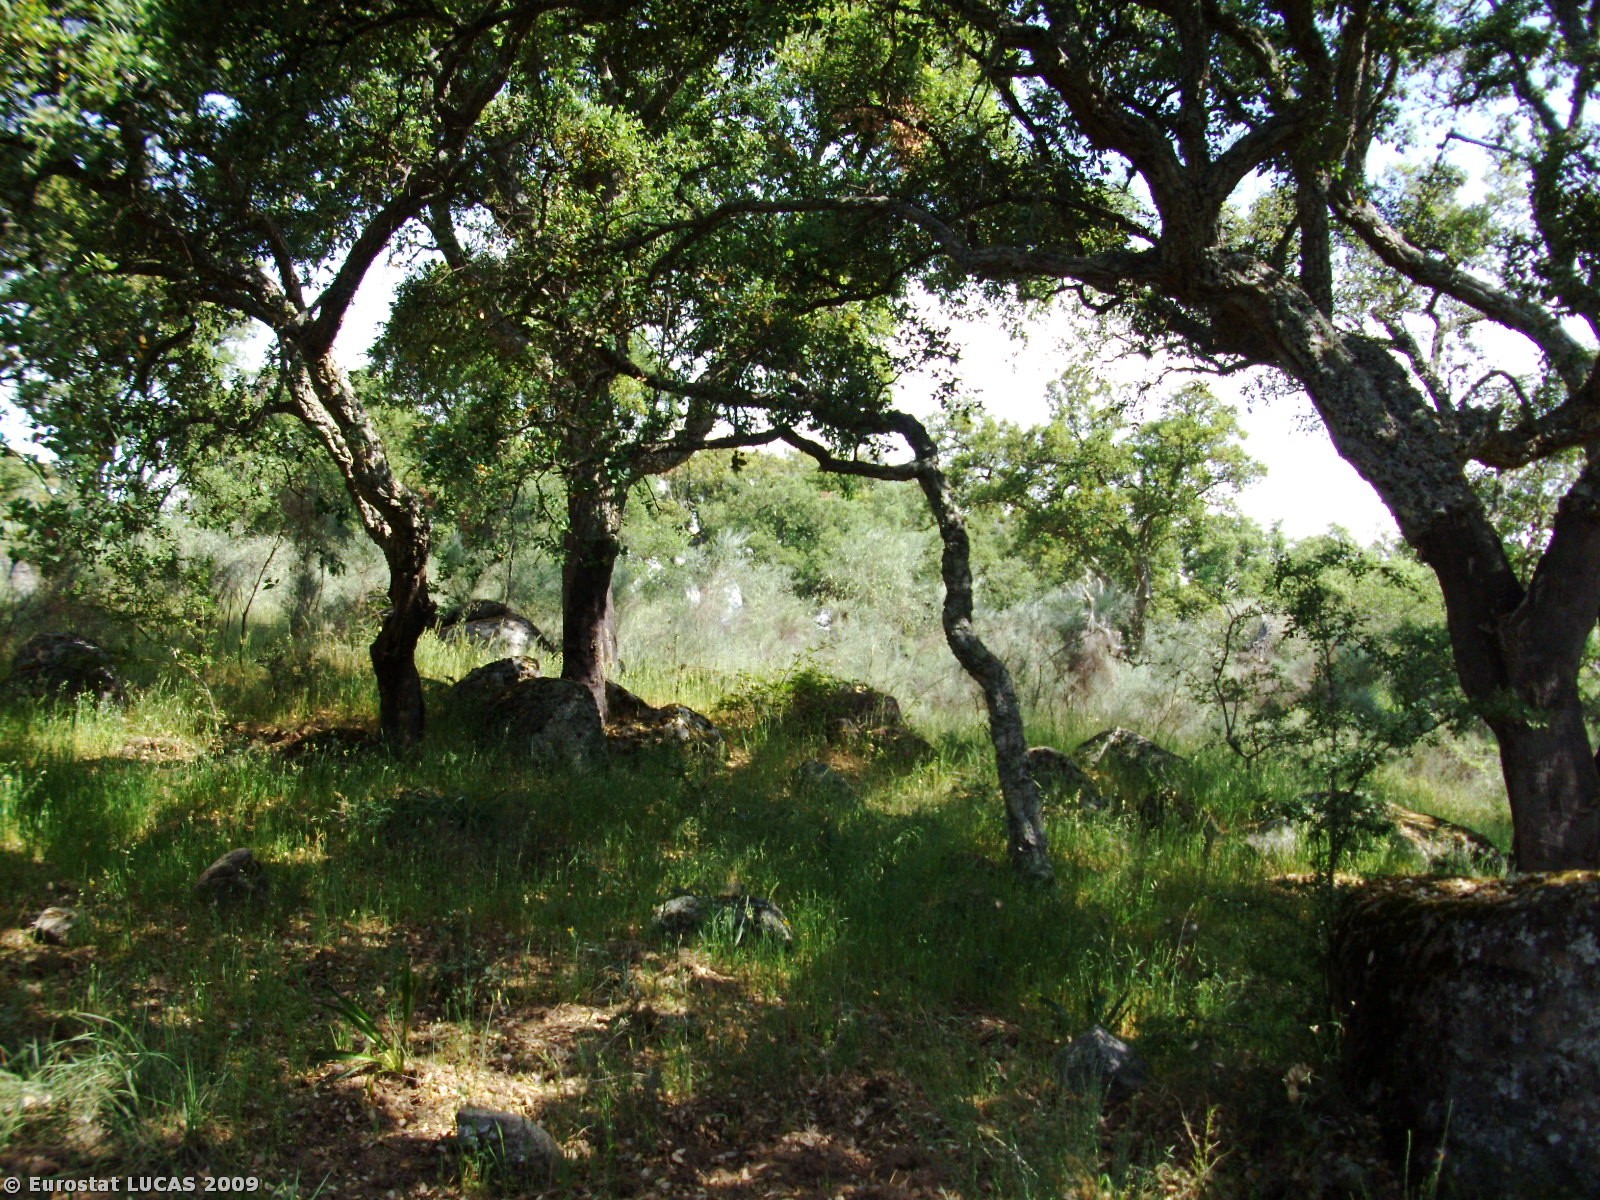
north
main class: Woodland
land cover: Broadleaved woodland
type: broadleaved evergreen forest
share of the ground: 50 - 75 %
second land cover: Shrubland with sparse tree cover
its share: 25 - 50 %
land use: Forestry
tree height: > 5 m
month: May
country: PT
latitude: 39.2778
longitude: -7.4650
